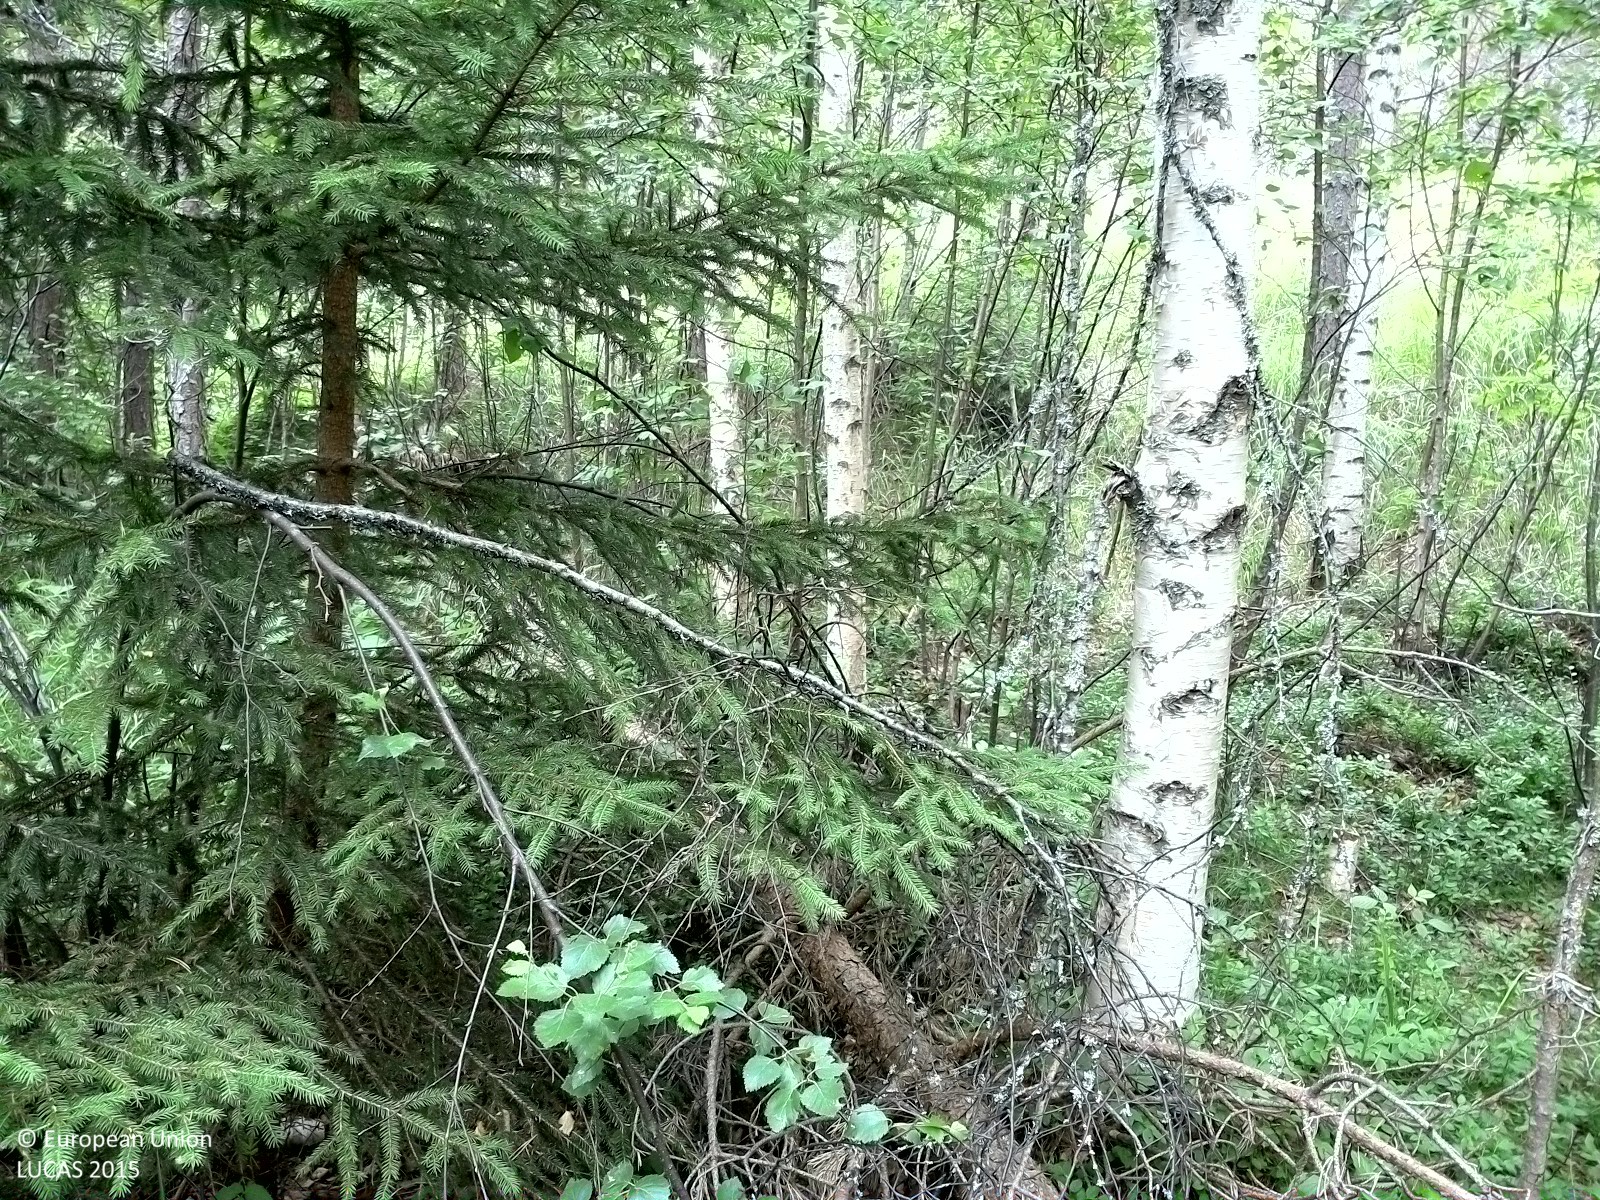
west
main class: Woodland
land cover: Other mixed woodland
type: boreal forest
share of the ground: > 75 %
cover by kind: coniferous forest trees 40 %, broadleaved forest trees 40 %, shrubs 15 %, herbaceous plants 5 %
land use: Forestry
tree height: > 5 m
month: July
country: SE
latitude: 62.5224
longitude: 17.7319
